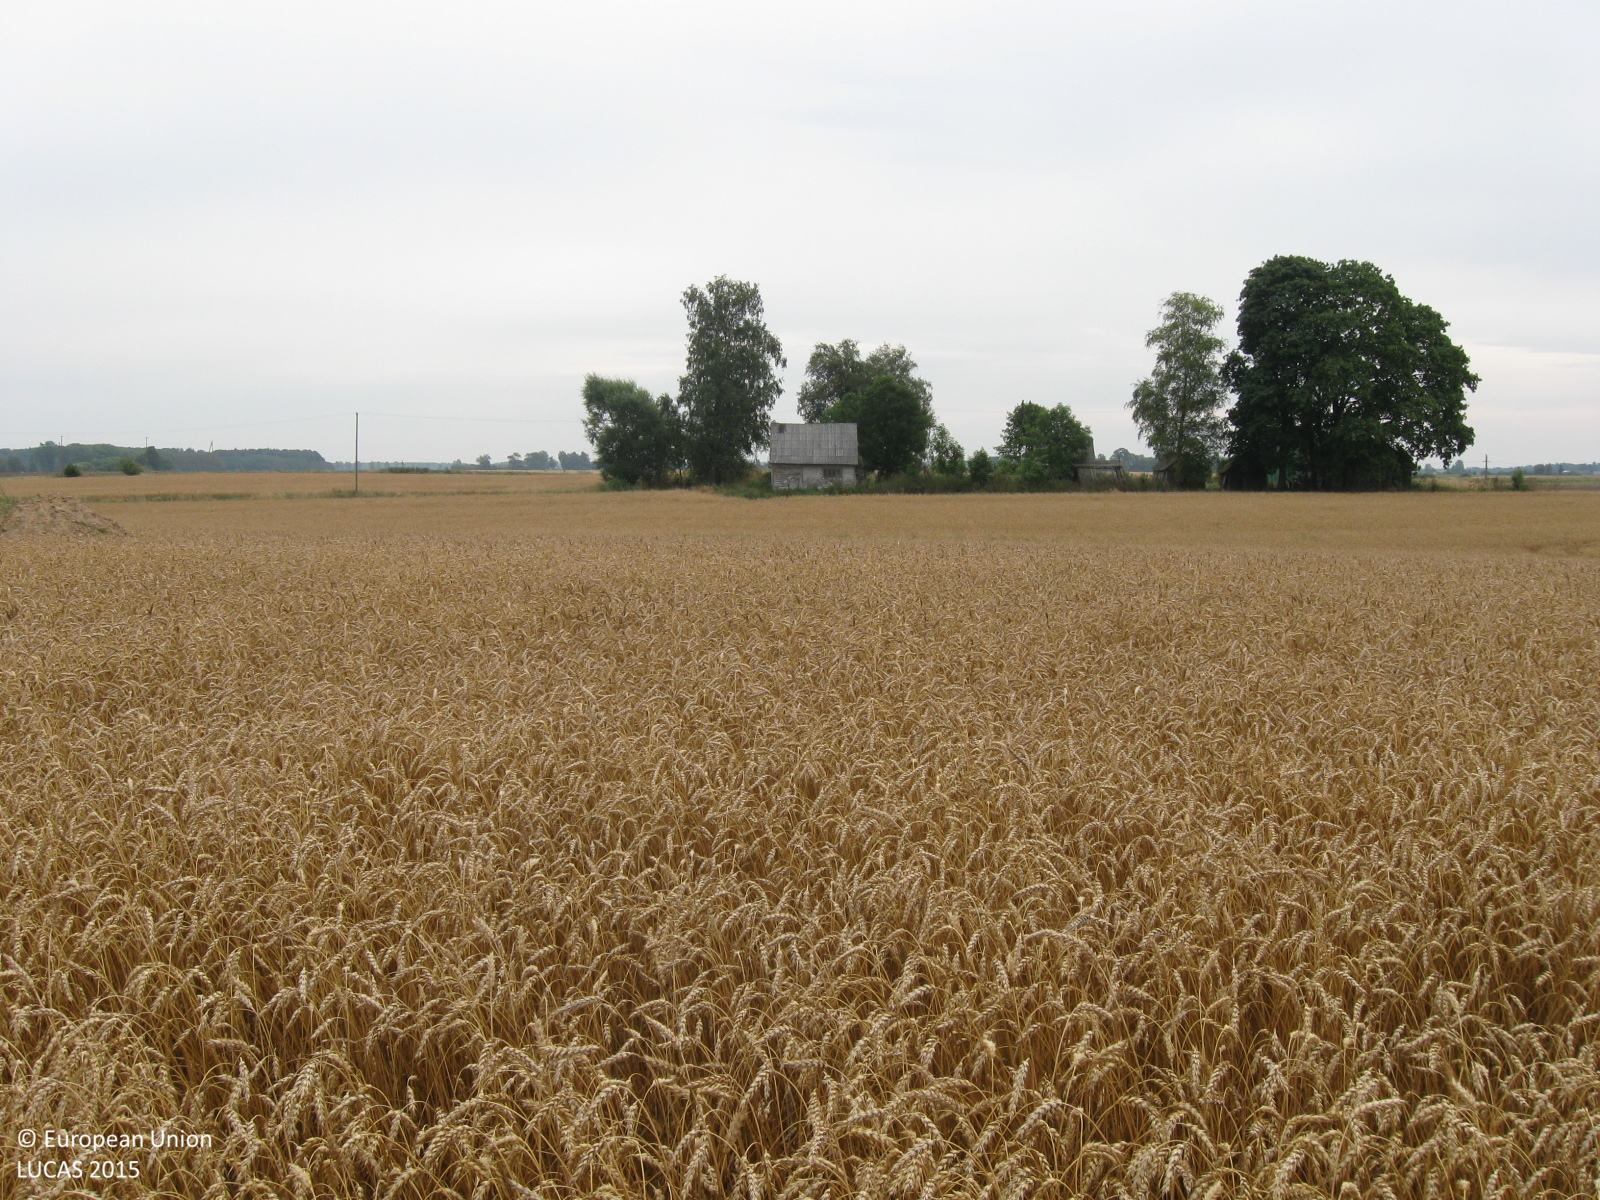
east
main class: Cropland
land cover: Common wheat
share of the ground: > 75 %
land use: Agriculture (excluding fallow land and kitchen gardens)
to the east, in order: Common wheat; Artificial constructions in urban areas; Common wheat
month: August
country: LT
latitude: 55.1168
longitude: 23.3893
